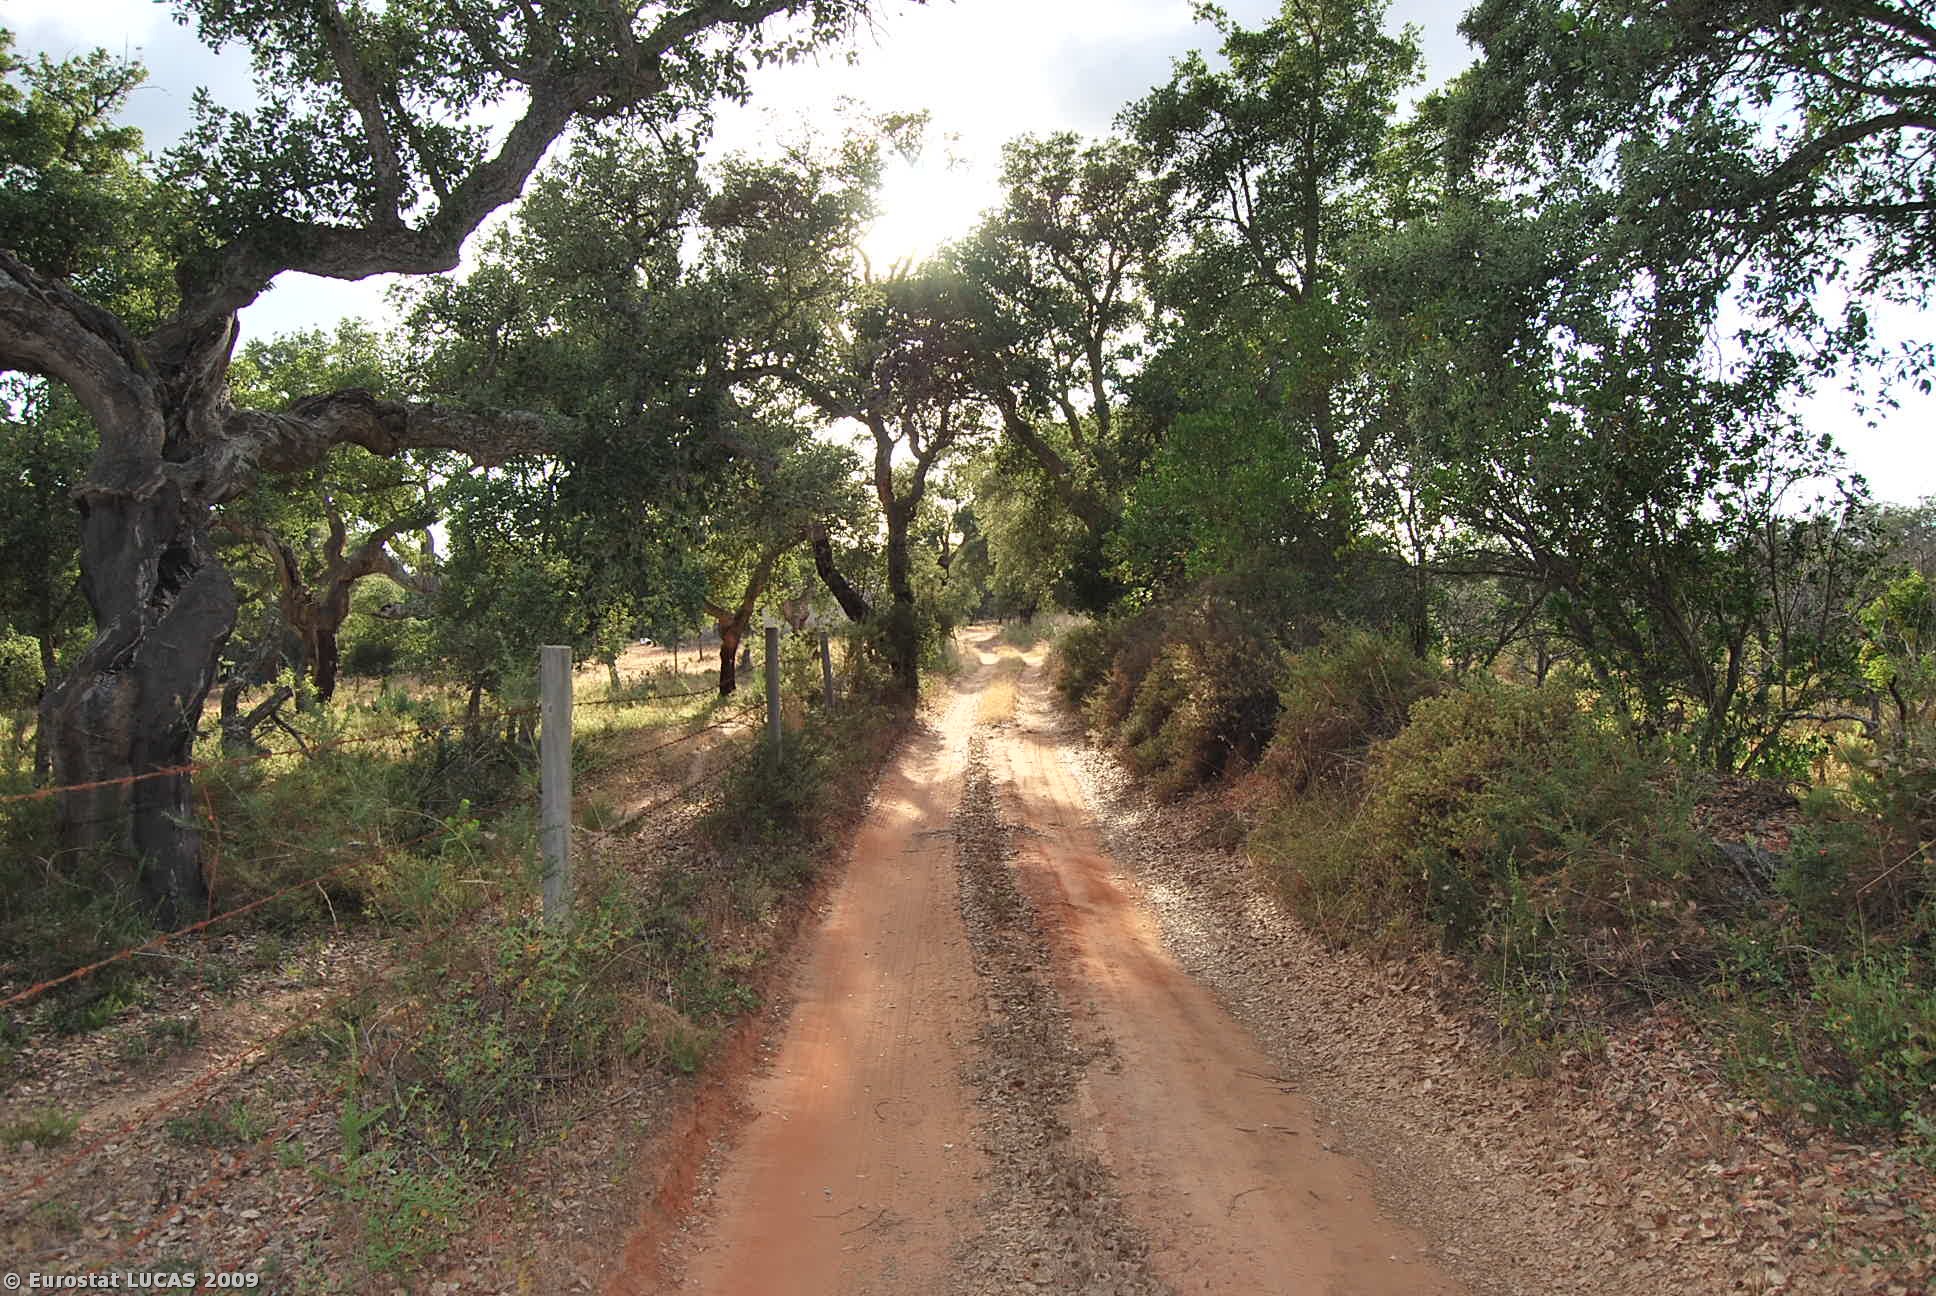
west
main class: Woodland
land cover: Broadleaved woodland
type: broadleaved evergreen forest
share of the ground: 25 - 50 %
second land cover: Spontaneously vegetated surfaces
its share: 50 - 75 %
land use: Forestry
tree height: > 5 m
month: June
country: PT
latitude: 38.0213
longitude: -8.7194
